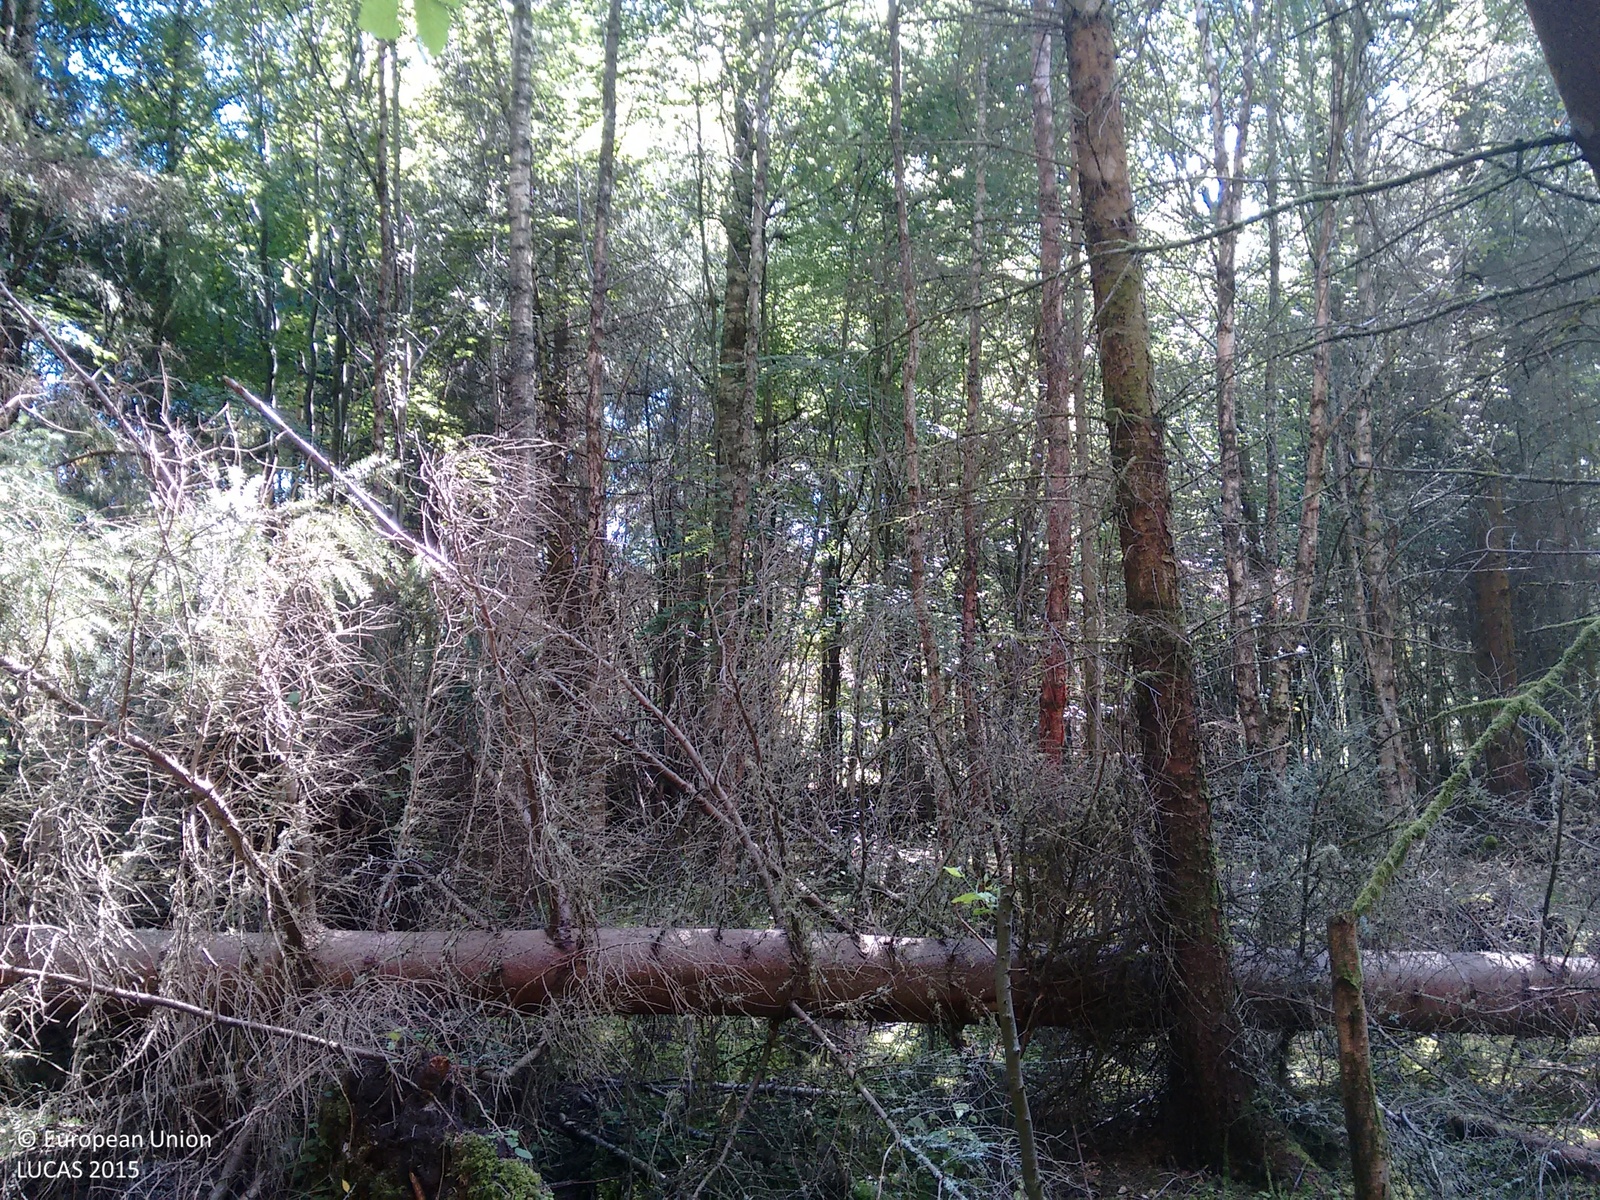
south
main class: Woodland
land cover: Spruce dominated mixed woodland
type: exotic forest
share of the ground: > 75 %
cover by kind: coniferous forest trees 70 %, broadleaved forest trees 30 %
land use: Forestry
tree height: > 5 m
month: August
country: GB
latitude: 57.7515
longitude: -4.0431
